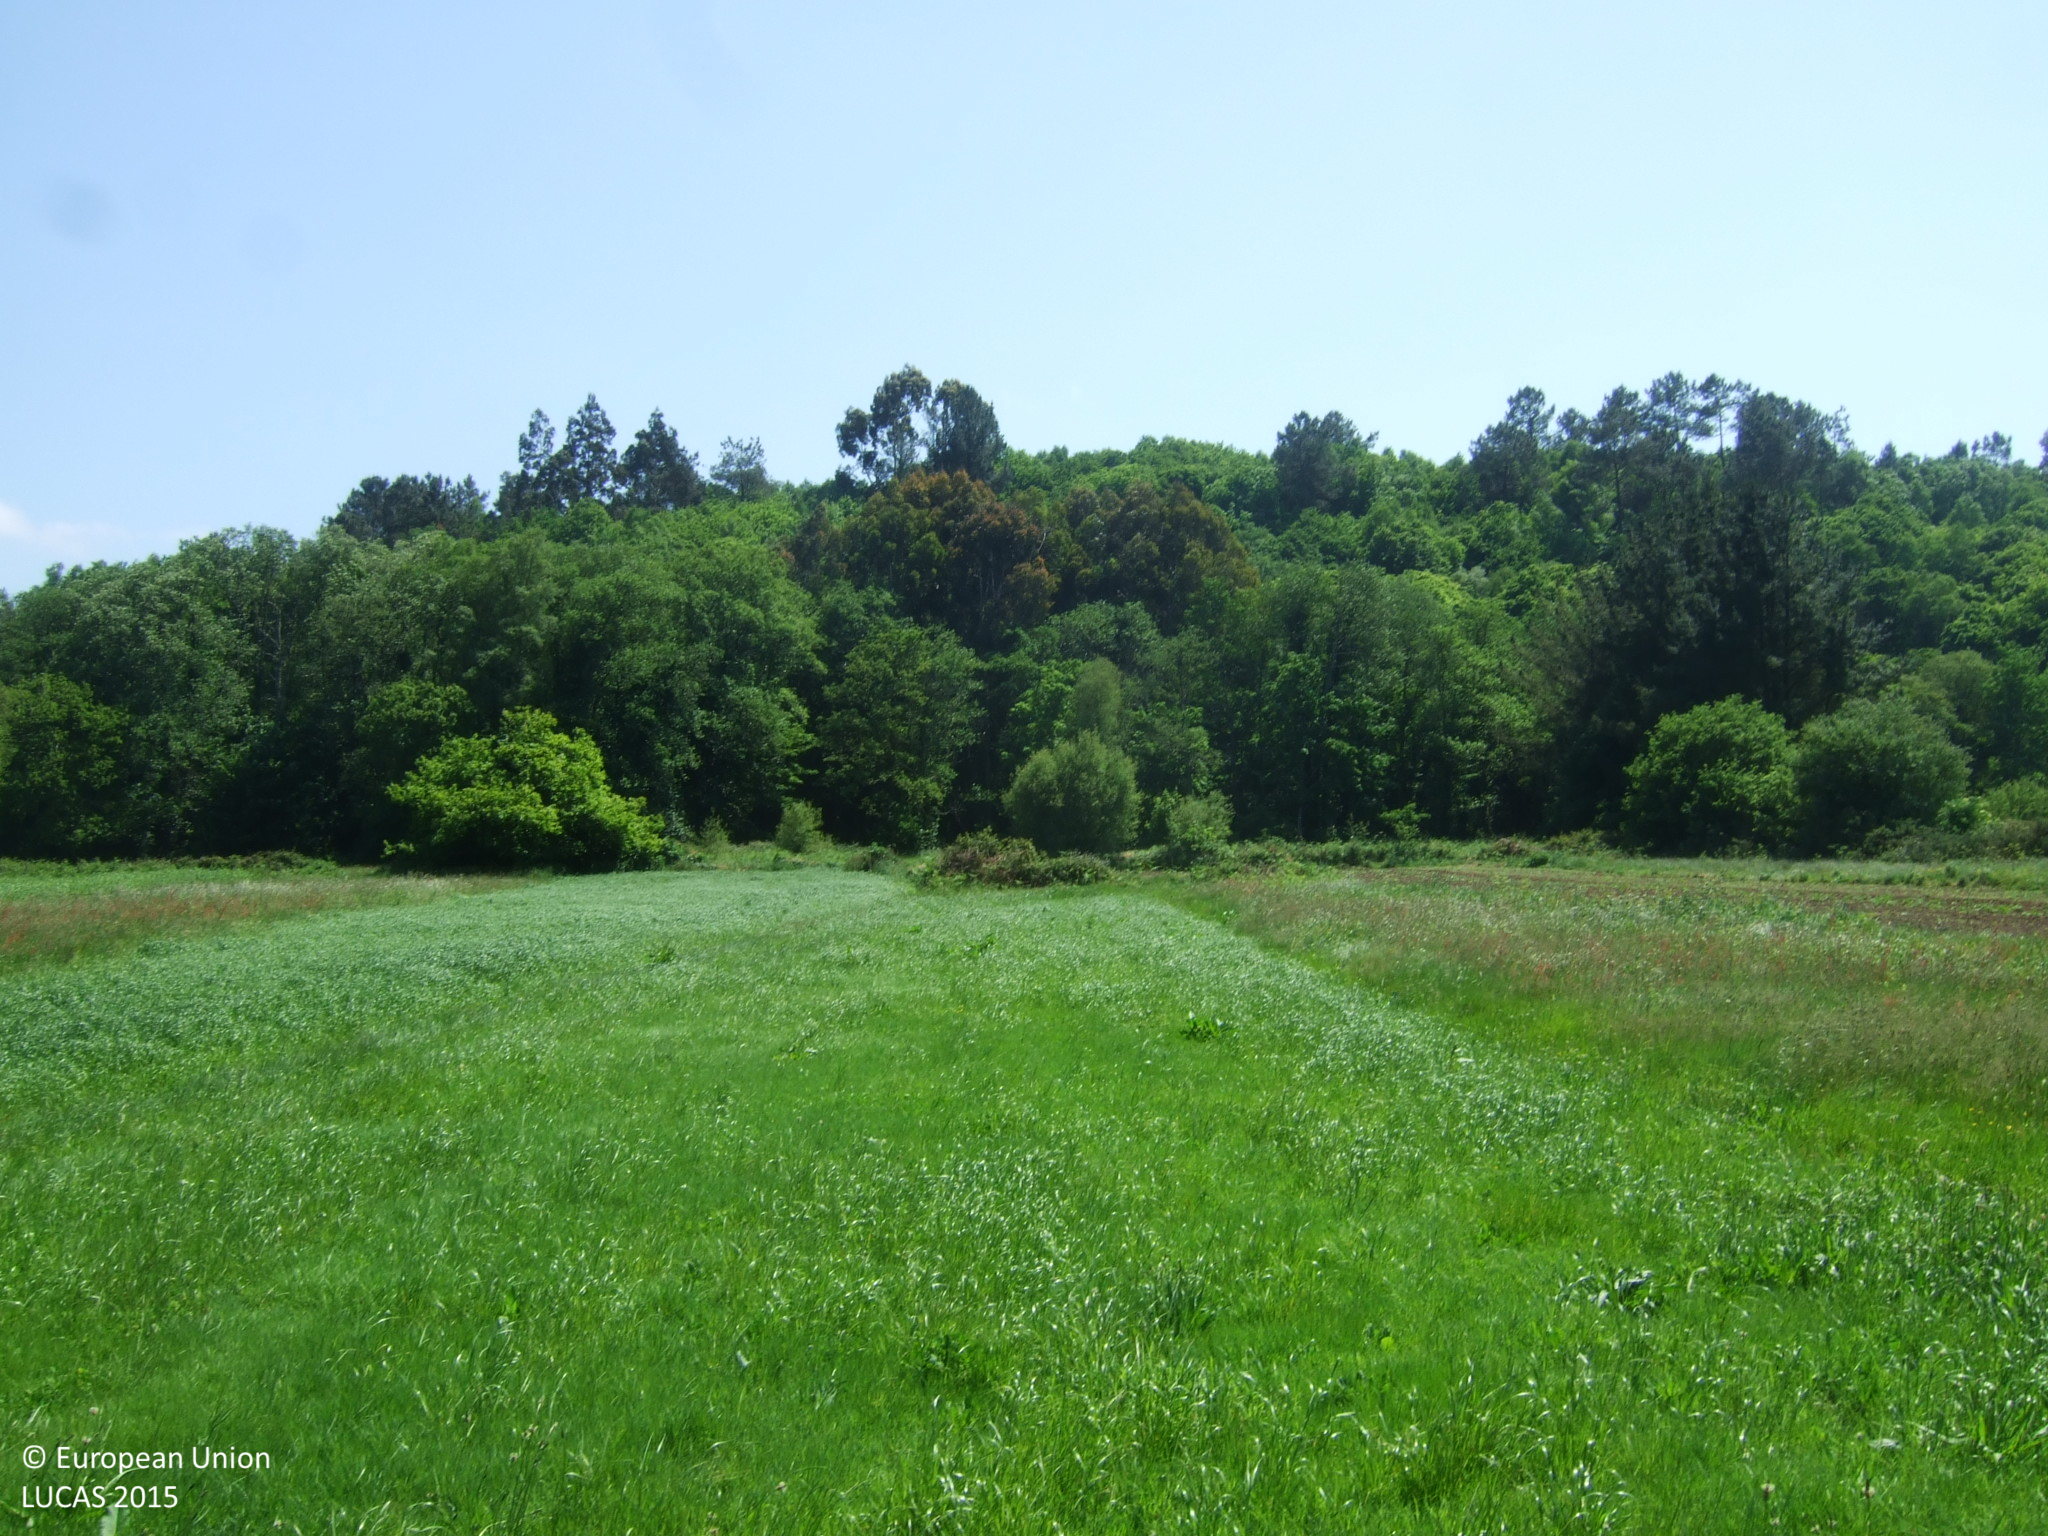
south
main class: Grassland
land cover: Grassland without tree/shrub cover
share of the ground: > 75 %
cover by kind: herbaceous plants 100 %
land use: Agriculture (excluding fallow land and kitchen gardens)
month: June
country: ES
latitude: 43.3098
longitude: -7.5000
